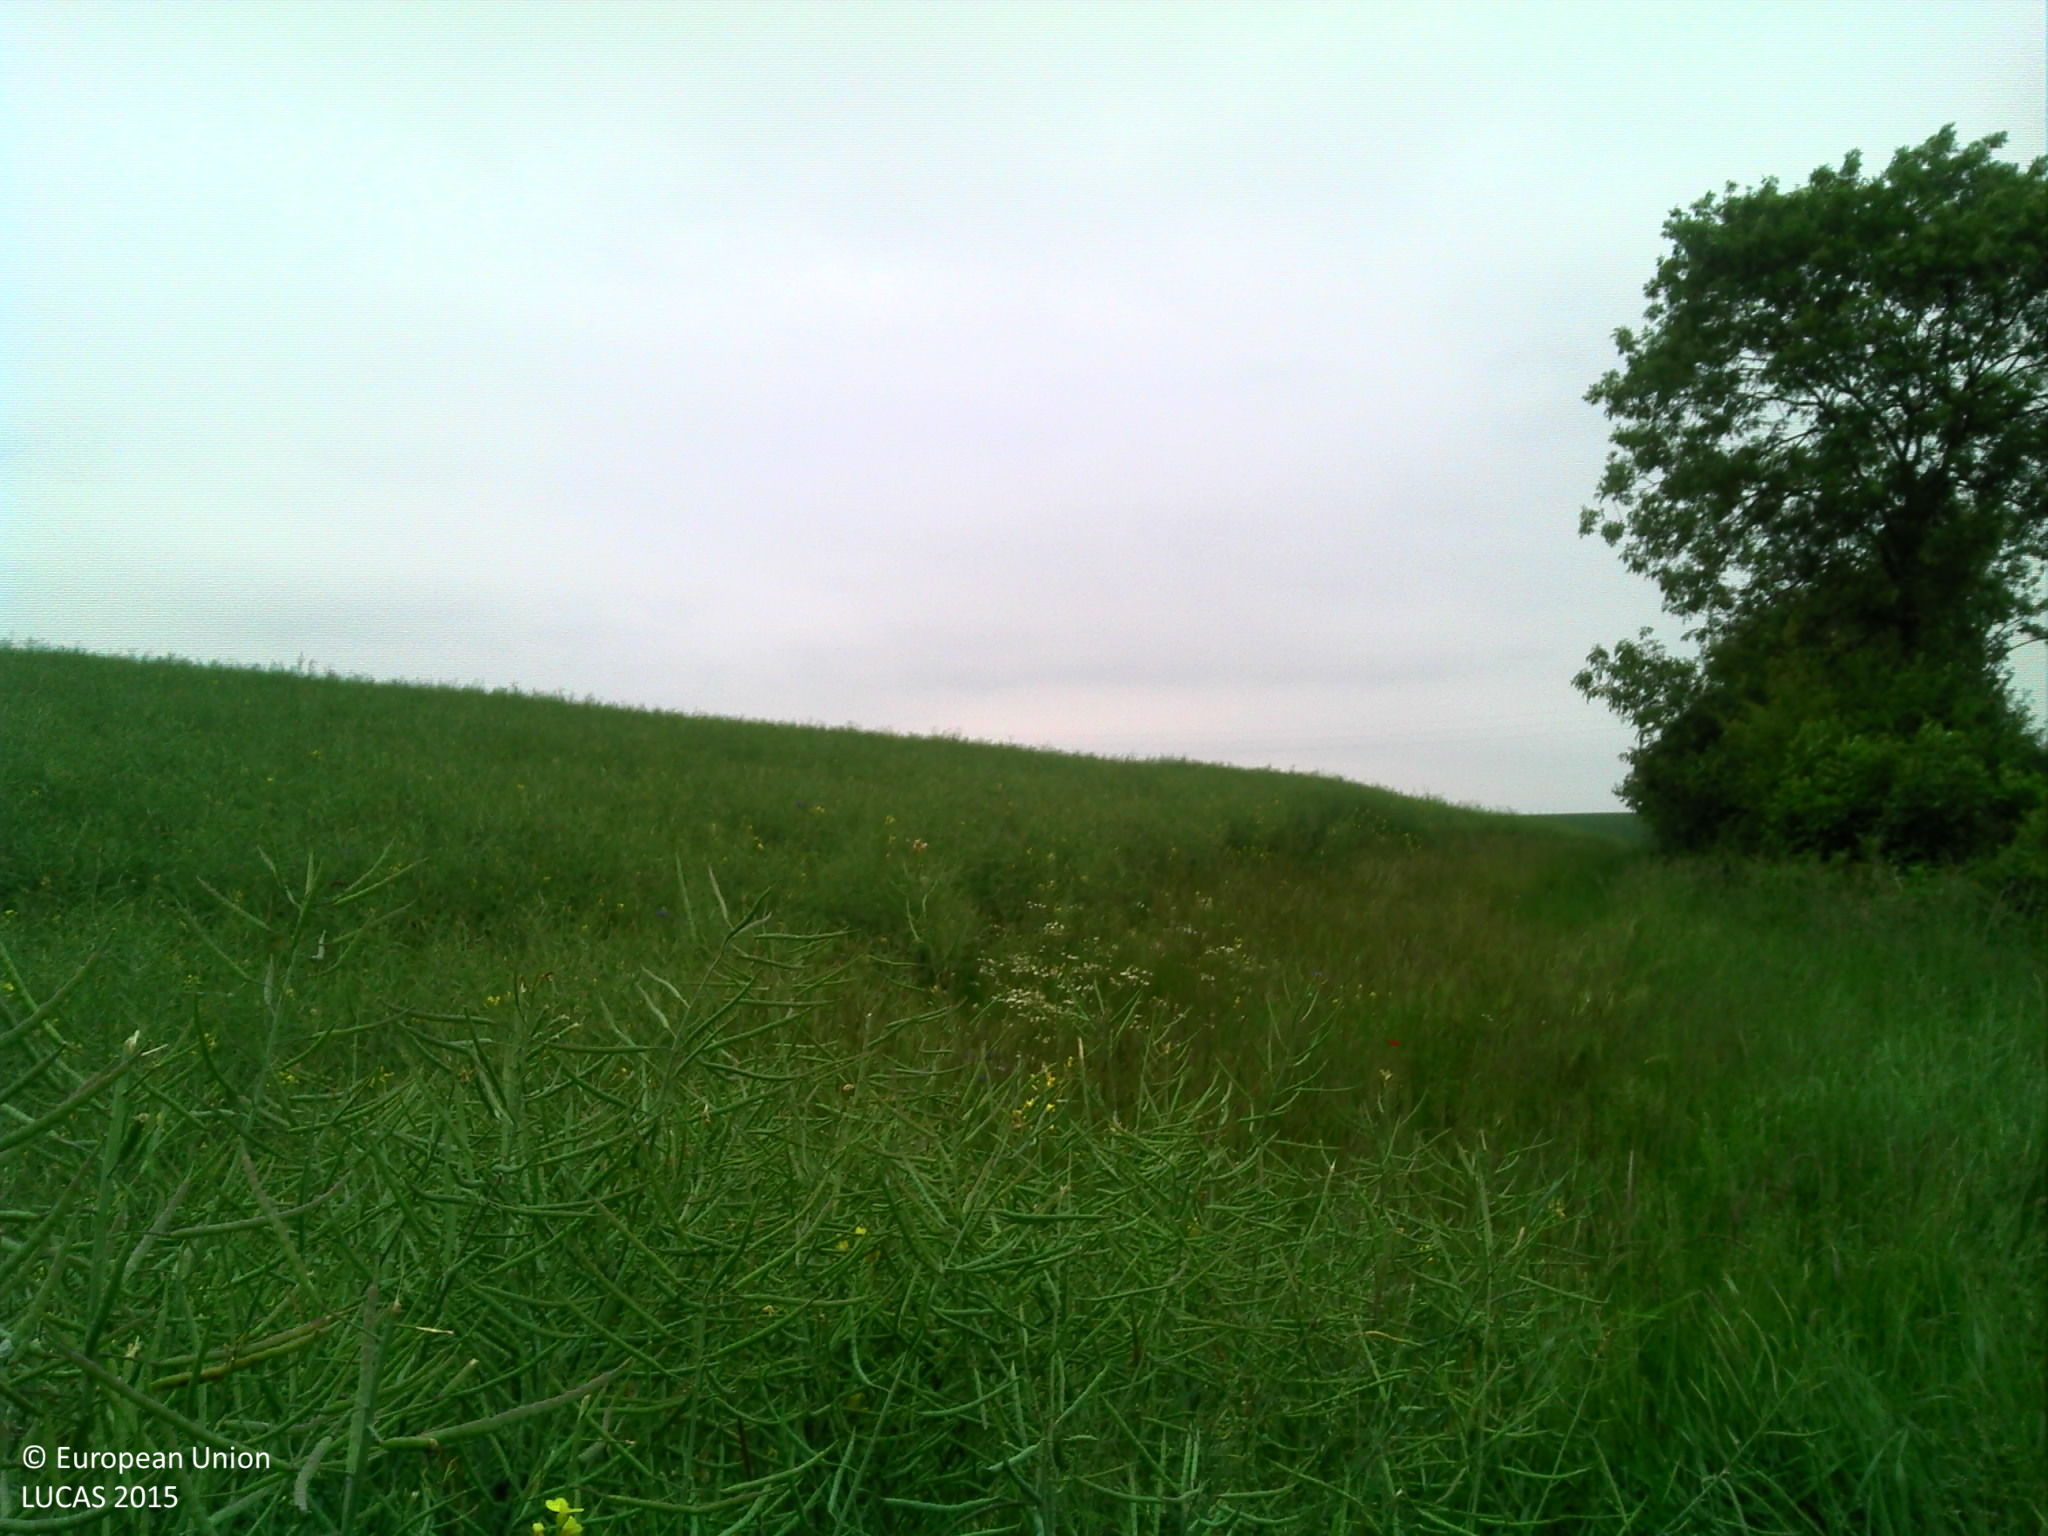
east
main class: Cropland
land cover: Barley
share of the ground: > 75 %
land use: Agriculture (excluding fallow land and kitchen gardens)
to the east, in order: Barley; Grassland without tree/shrub cover; Rape and turnip rape; Grassland without tree/shrub cover; Electric lines; Grassland without tree/shrub cover; Tracks; Grass margins; Managed hedges; Fences; Grassland without tree/shrub cover
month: May
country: FR
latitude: 47.9026
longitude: 6.1080
